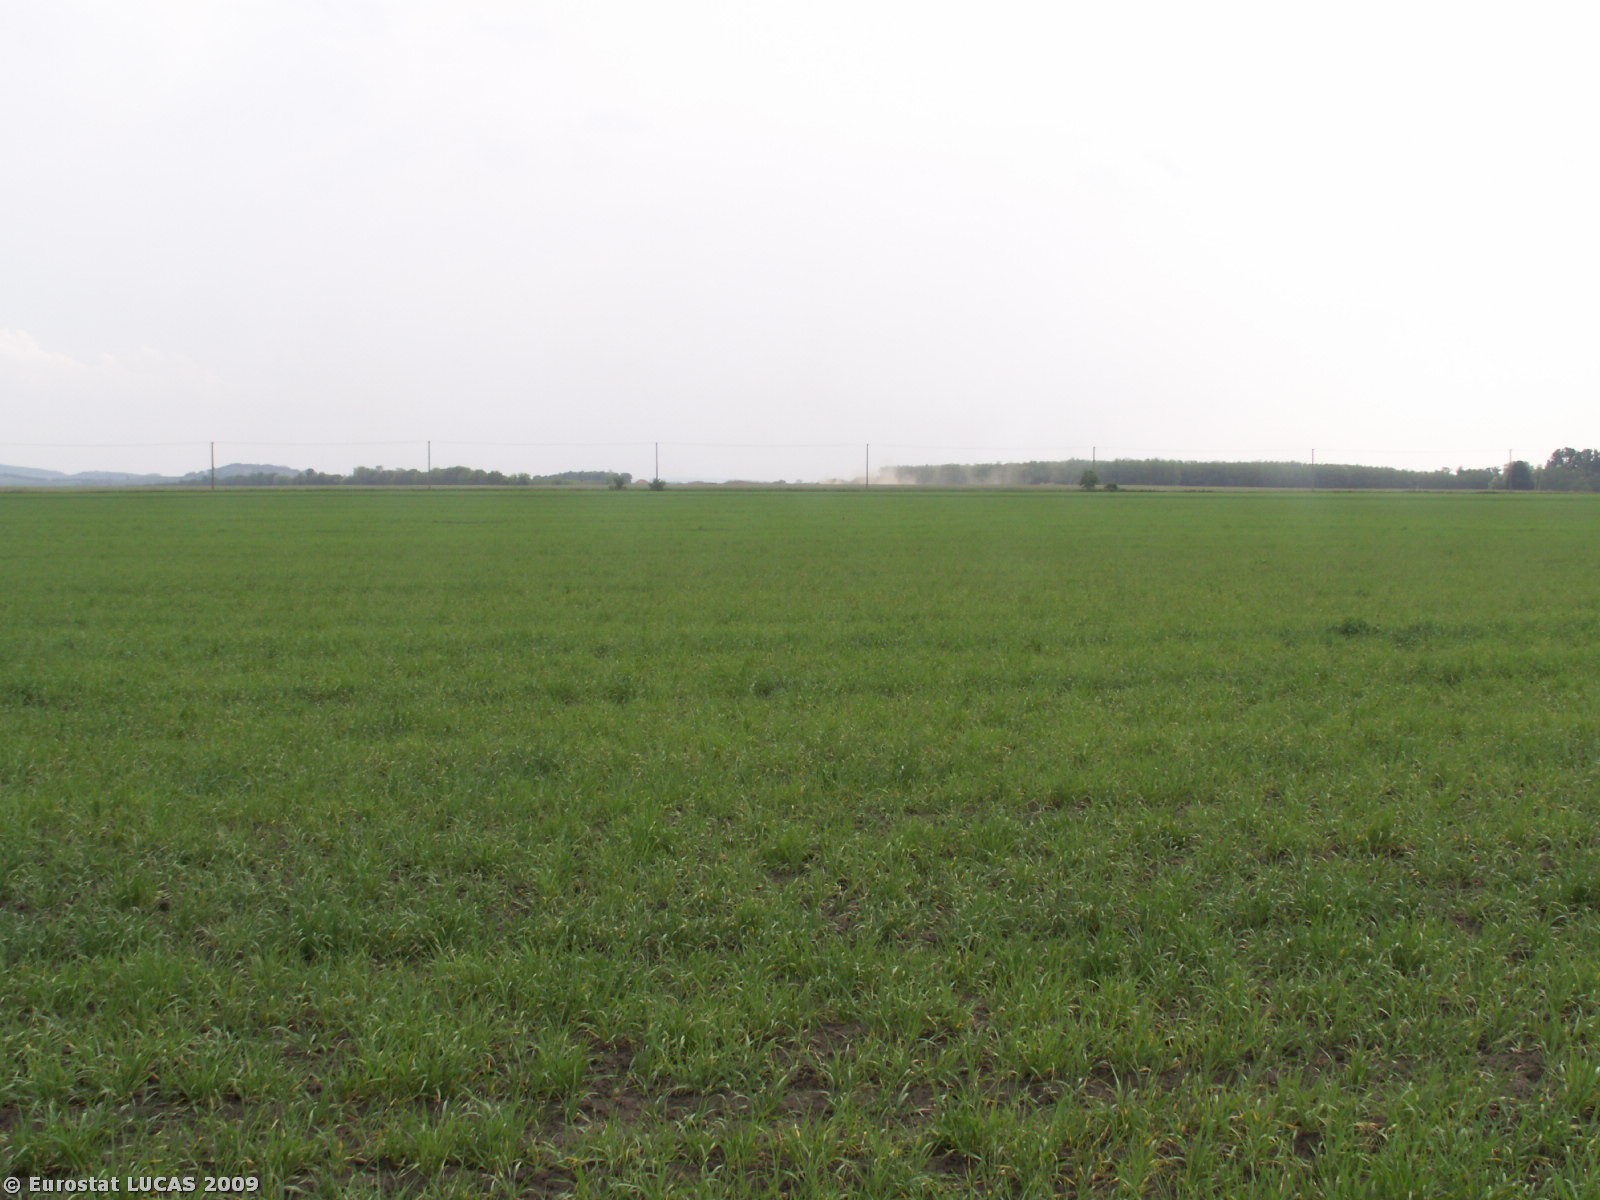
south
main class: Cropland
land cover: Barley
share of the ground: > 75 %
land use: Agriculture (excluding fallow land and kitchen gardens)
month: May
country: CZ
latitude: 48.8077
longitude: 16.5015
